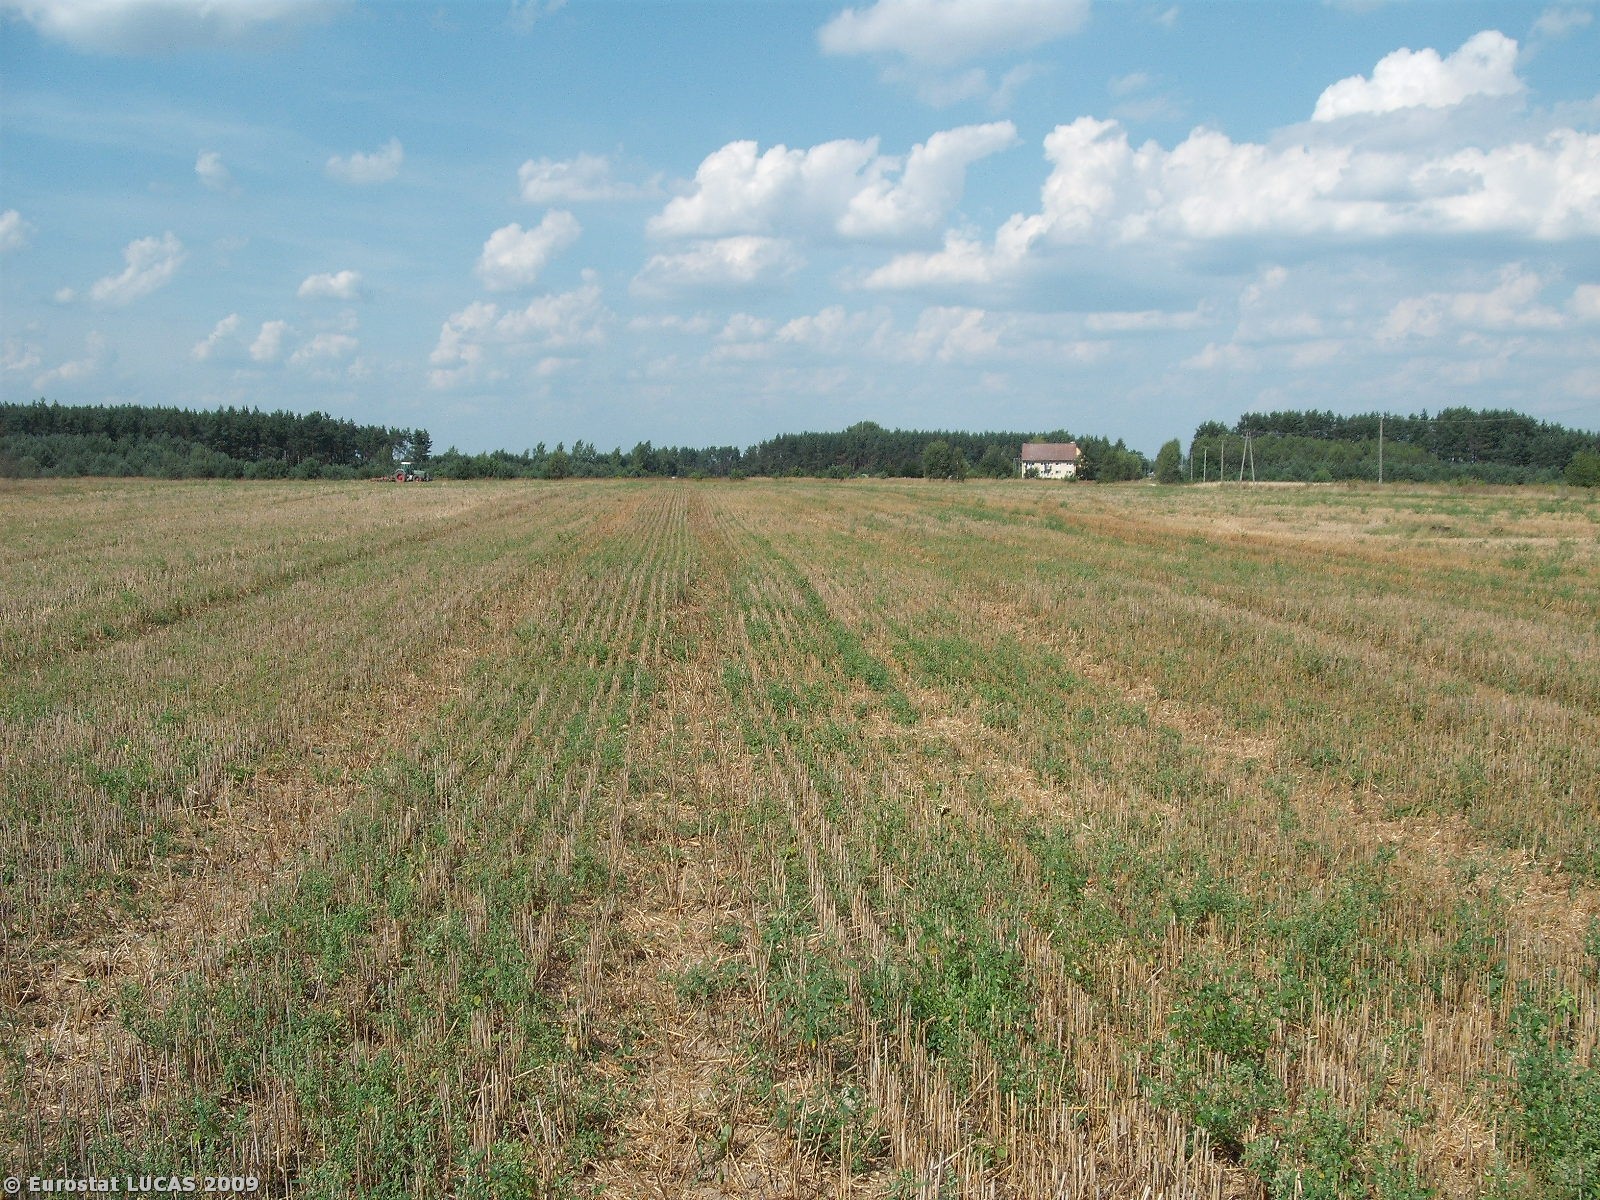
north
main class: Cropland
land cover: Triticale
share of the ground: < 10 %
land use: Agriculture (excluding fallow land and kitchen gardens)
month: August
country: PL
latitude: 50.5681
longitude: 20.7000
